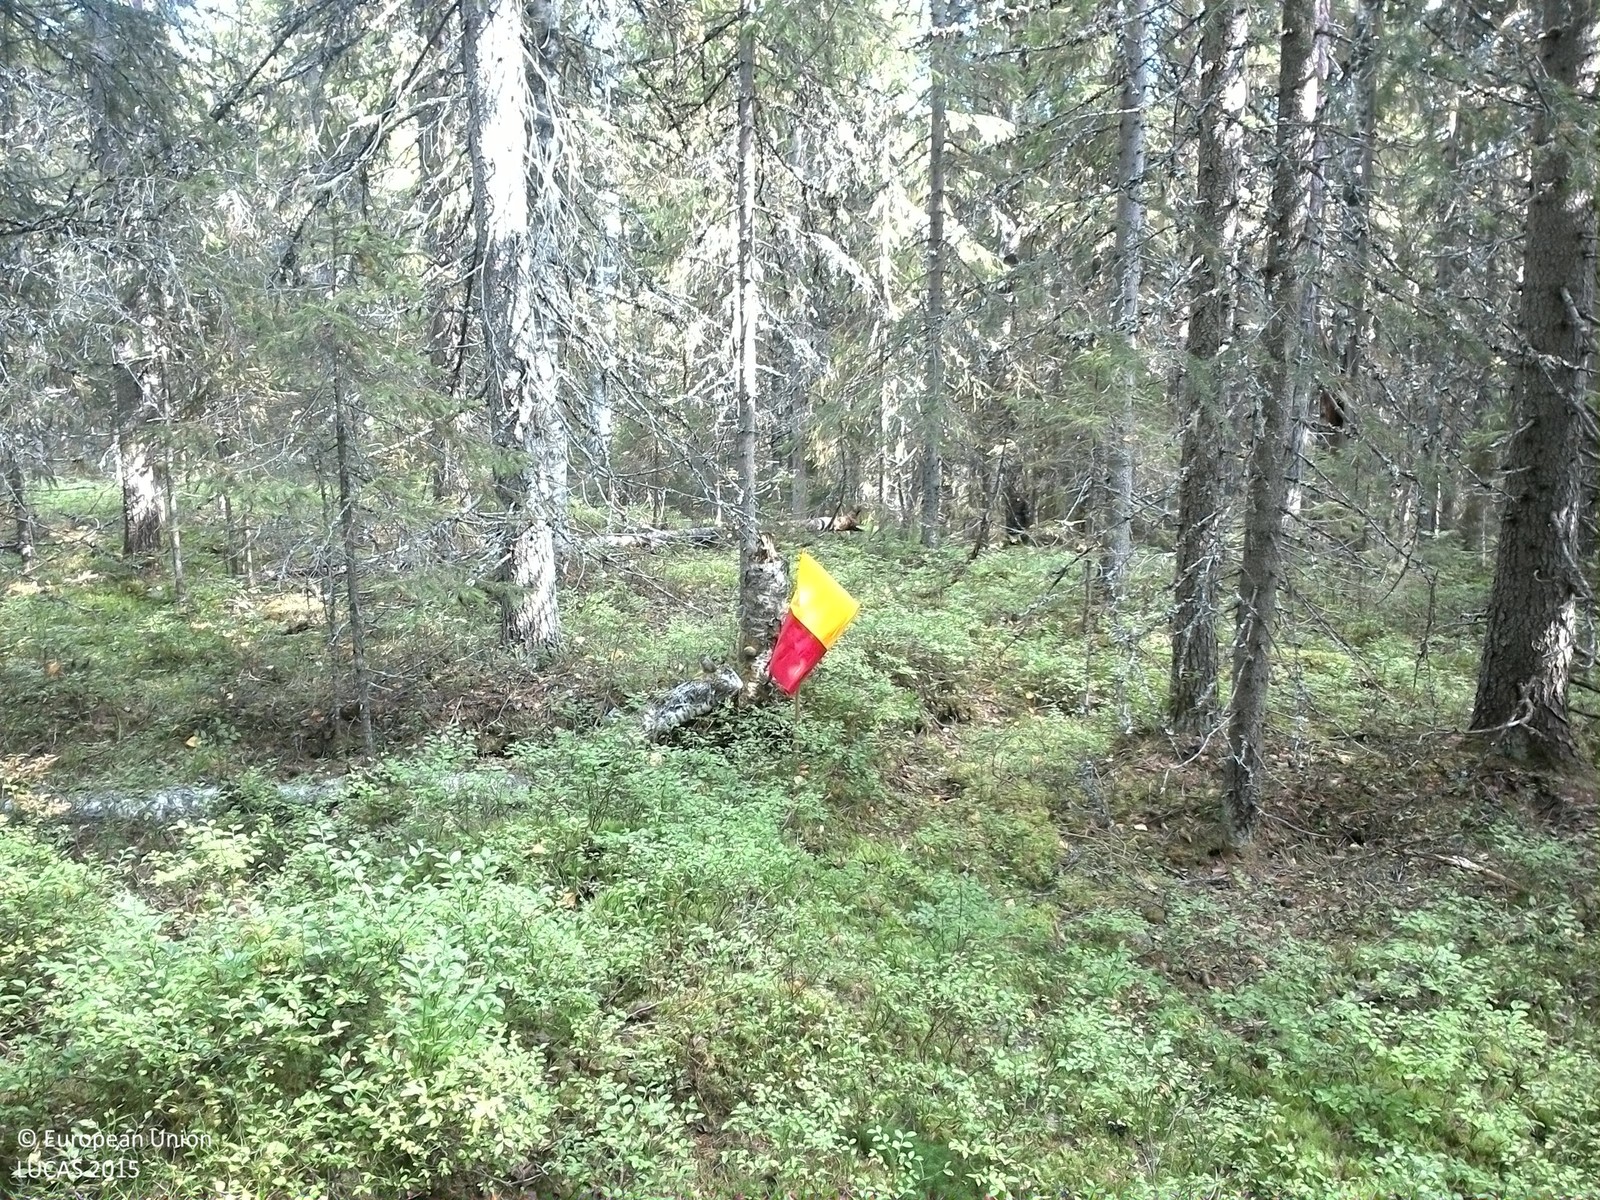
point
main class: Woodland
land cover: Spruce dominated coniferous woodland
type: boreal forest
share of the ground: 50 - 75 %
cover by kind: coniferous forest trees 60 %, shrubs 20 %, lichens and mosses 15 %, broadleaved forest trees 5 %
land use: Forestry
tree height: > 5 m
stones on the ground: 25 - 50 %
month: September
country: SE
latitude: 63.8824
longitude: 16.5479
